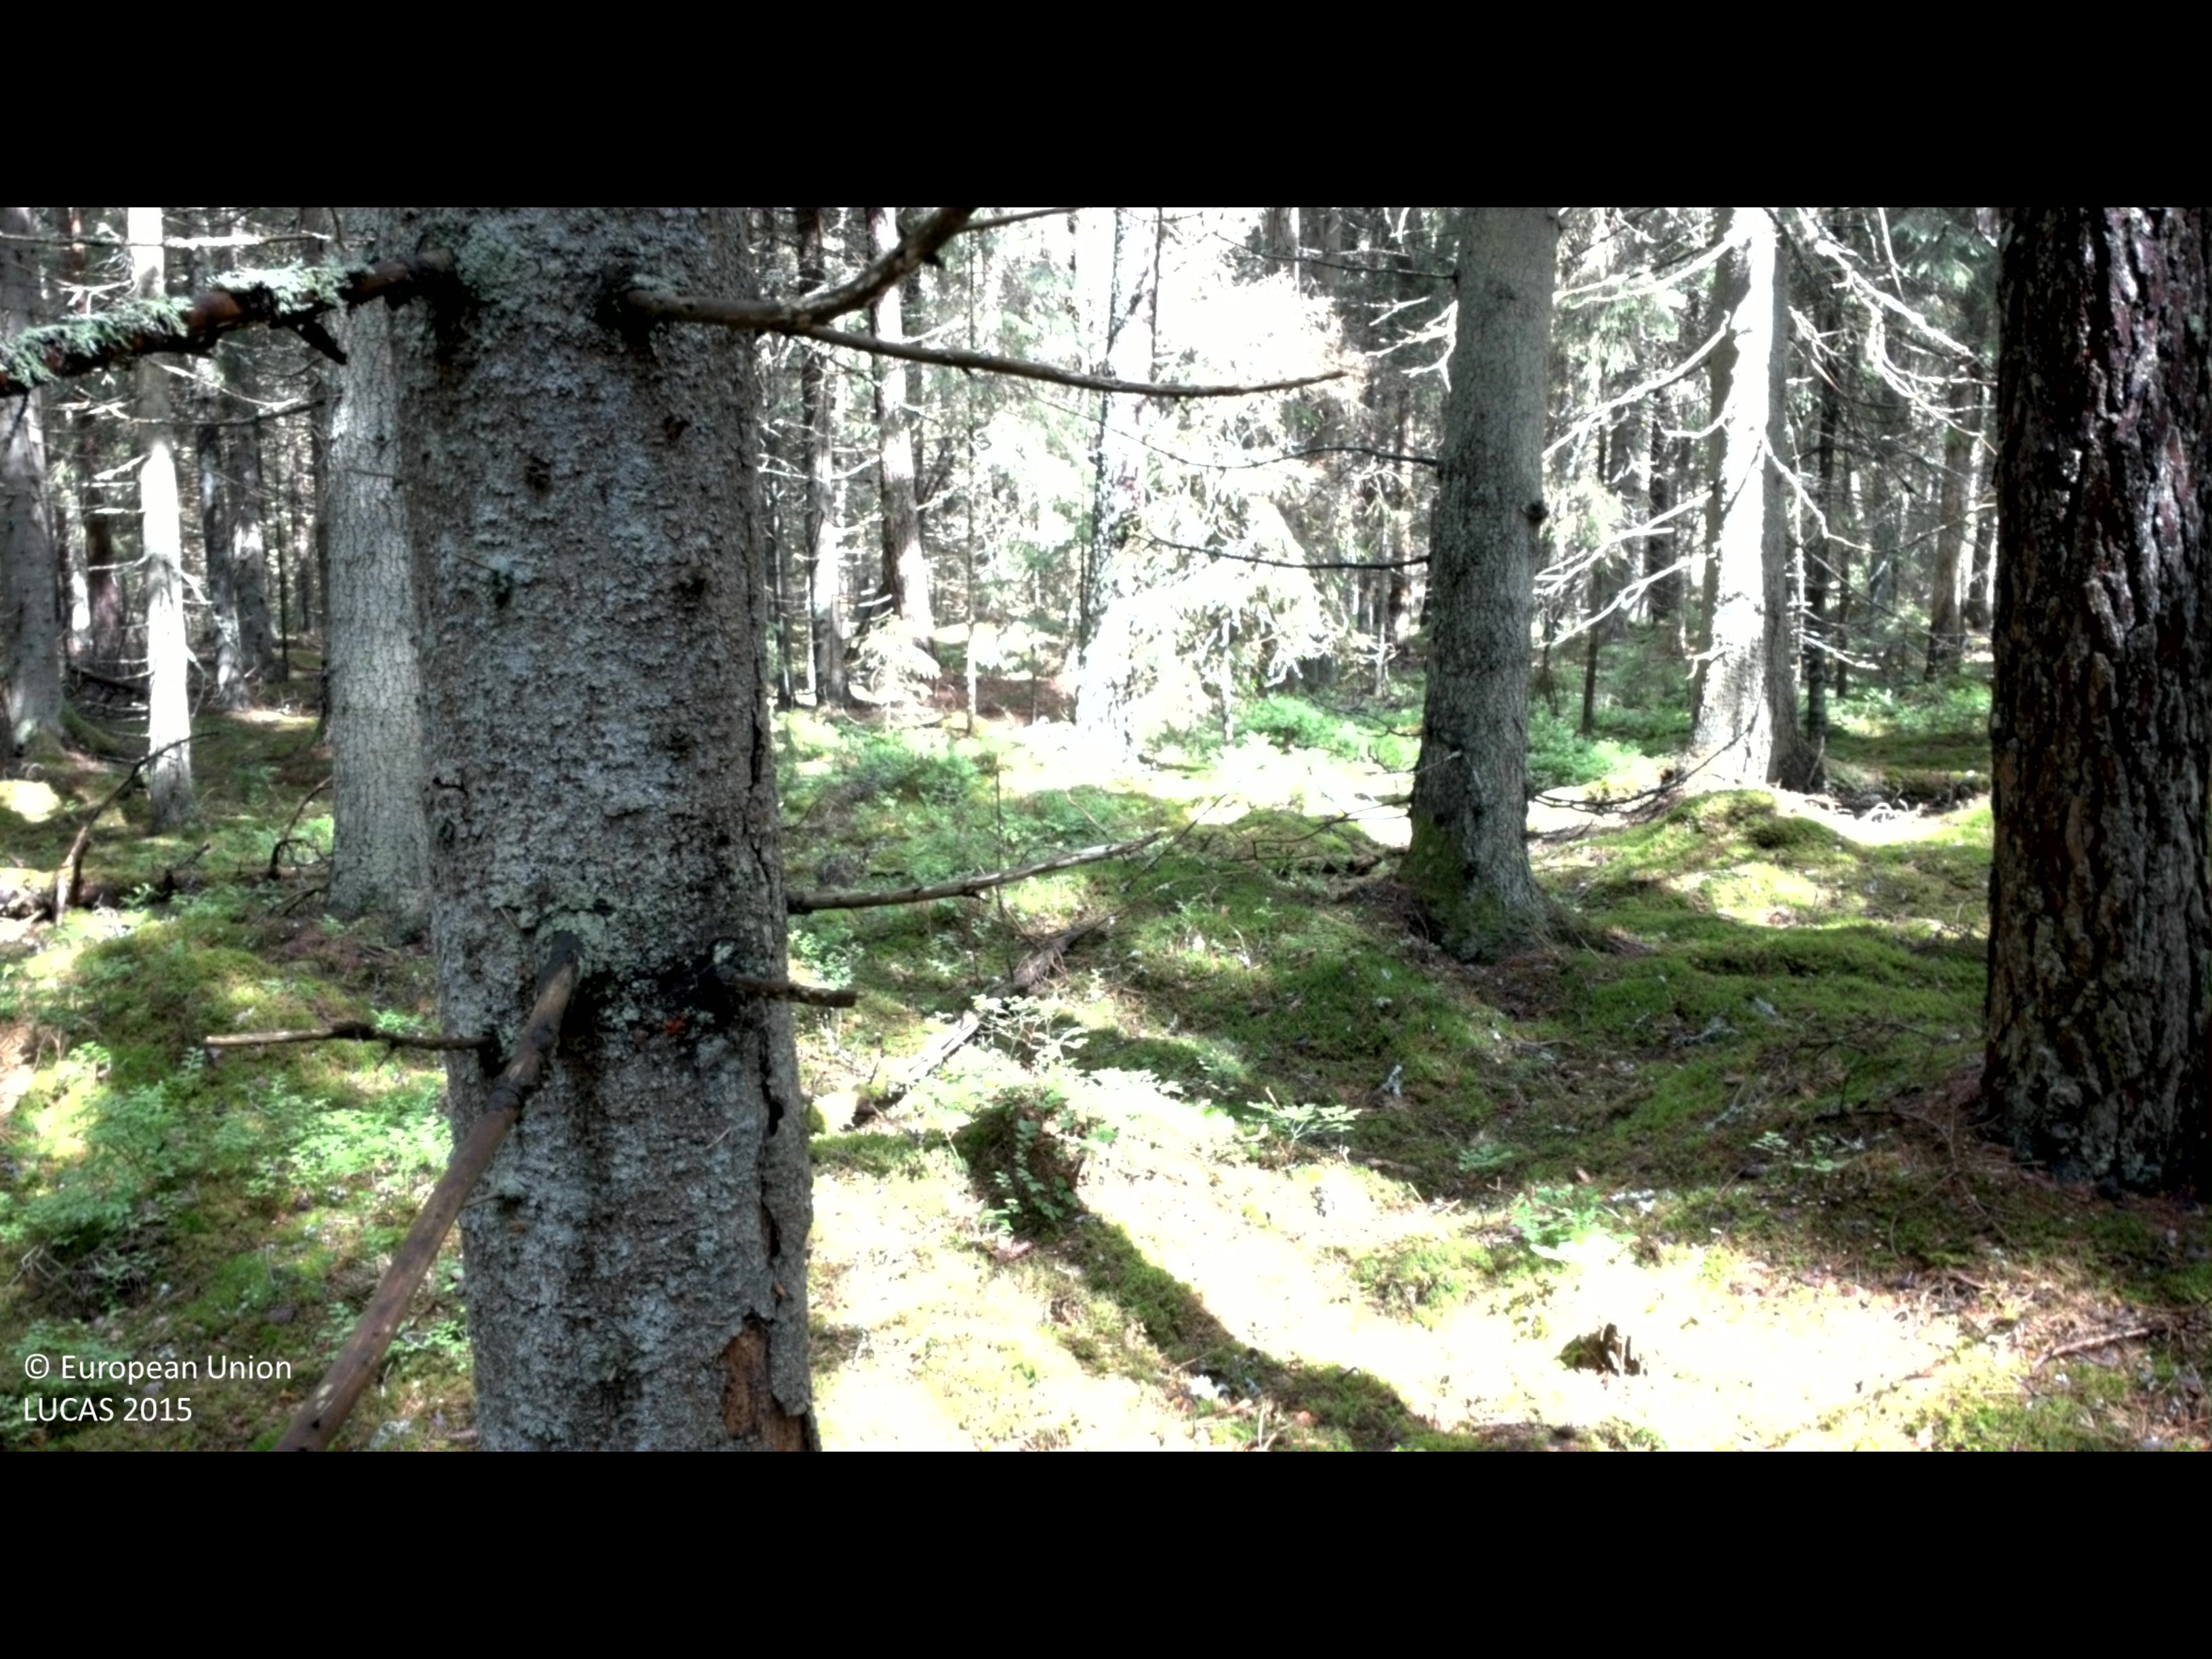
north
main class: Woodland
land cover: Spruce dominated coniferous woodland
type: boreal forest
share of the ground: > 75 %
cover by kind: coniferous forest trees 80 %, shrubs 10 %, lichens and mosses 10 %
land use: Forestry
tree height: > 5 m
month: June
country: SE
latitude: 58.0623
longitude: 16.1150
